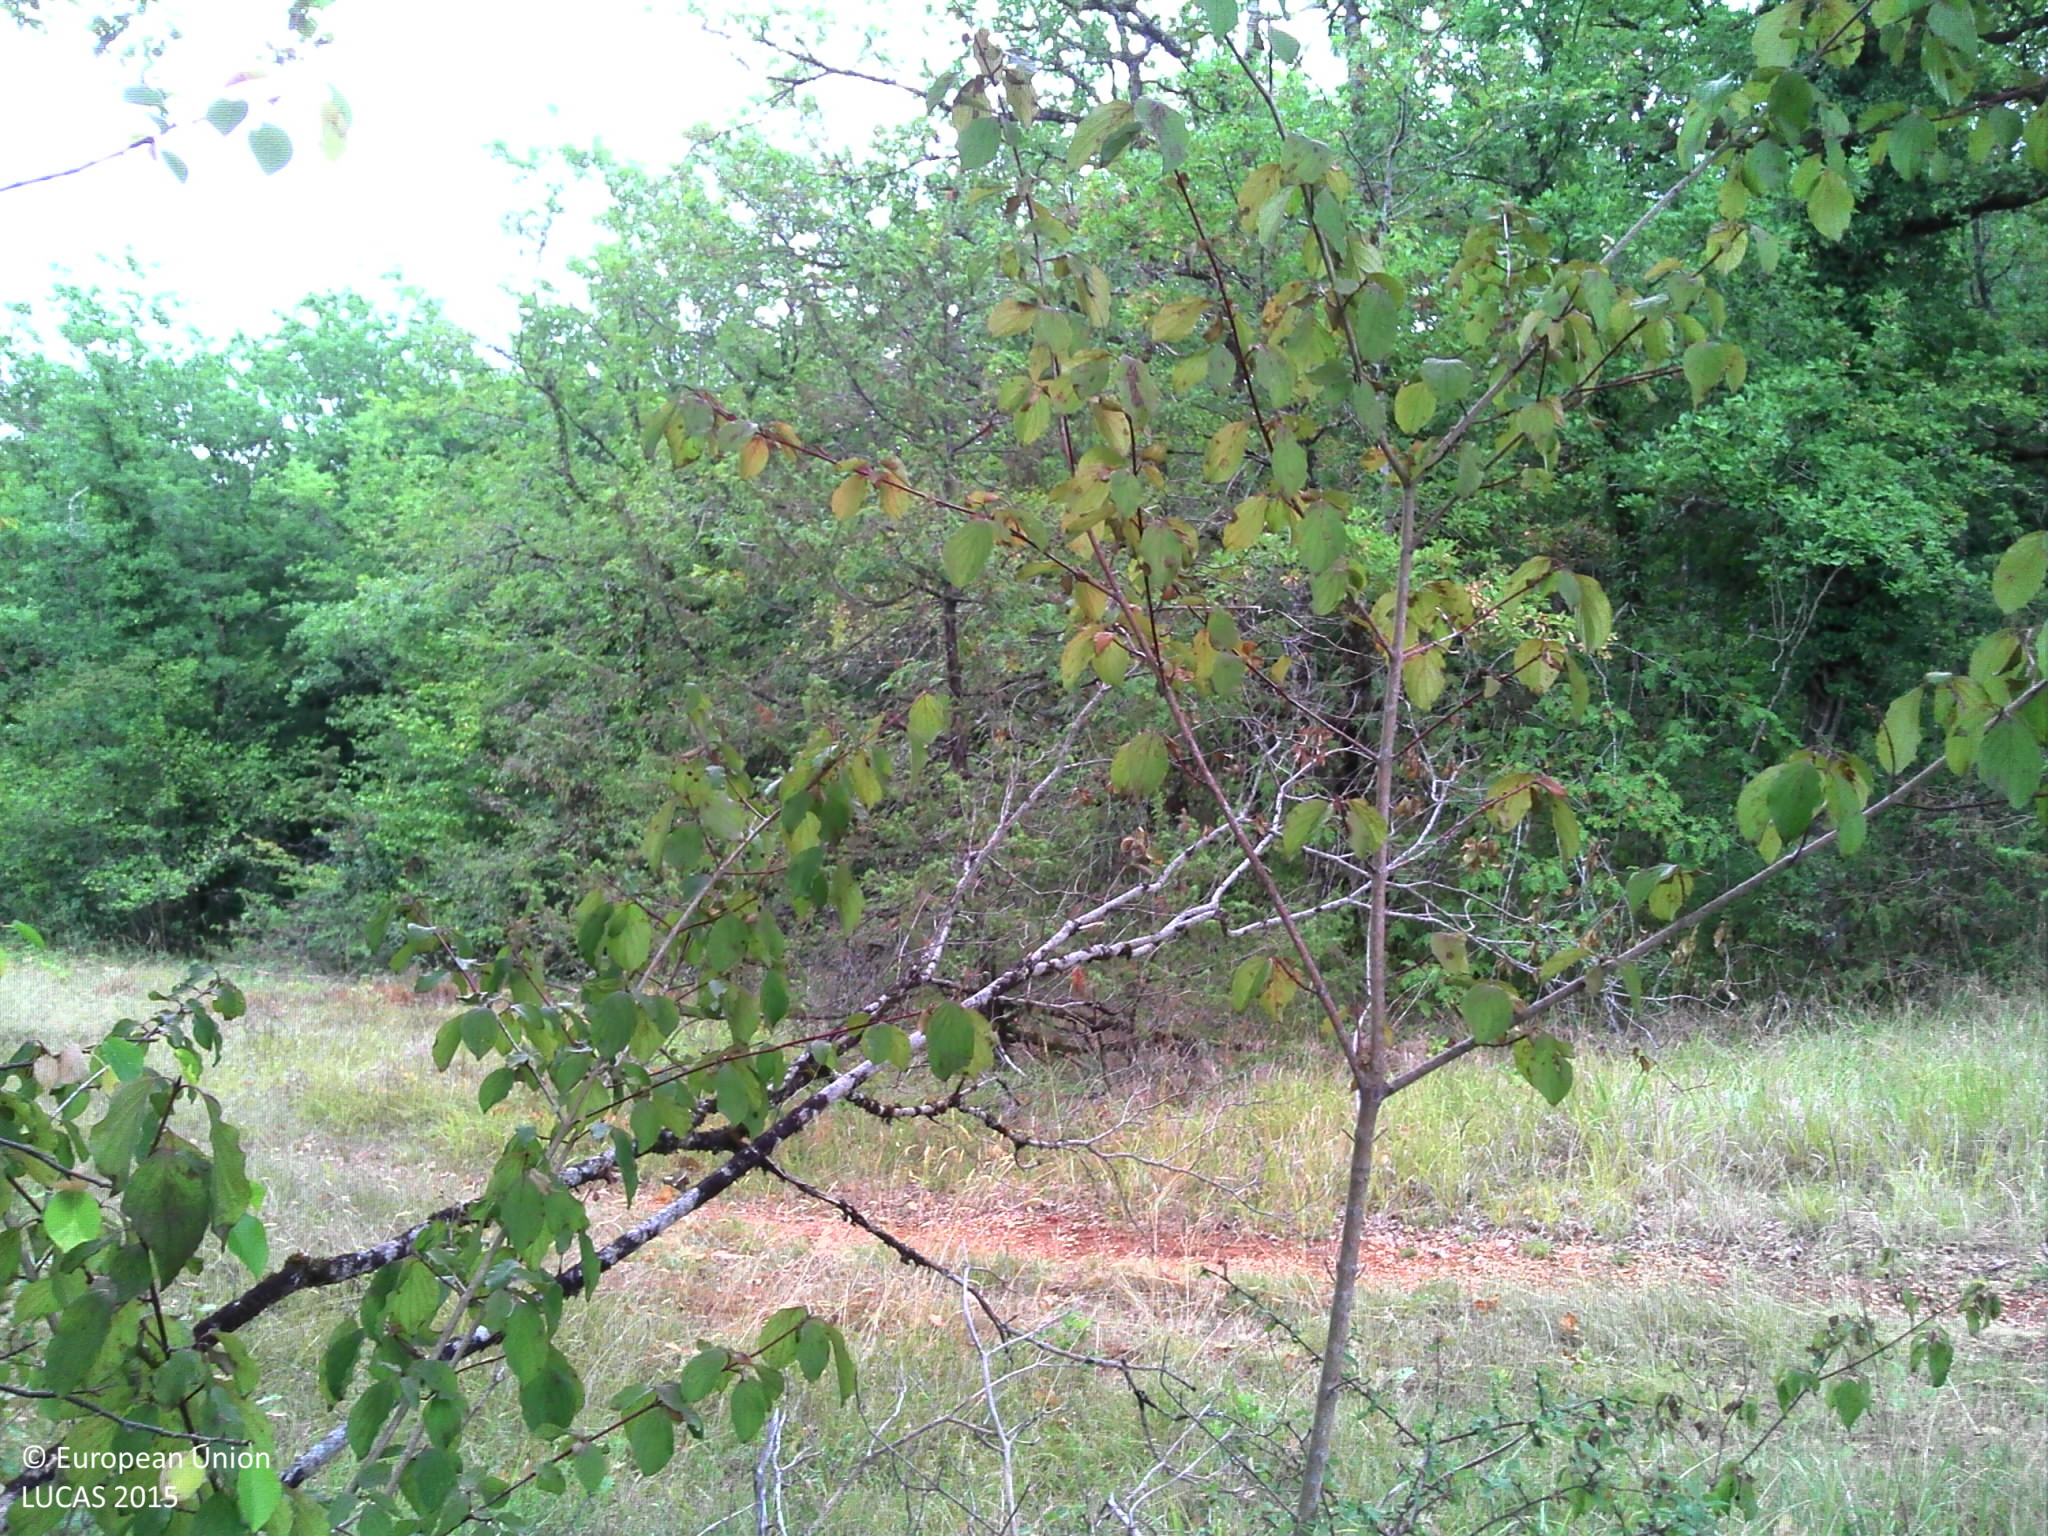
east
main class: Woodland
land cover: Broadleaved woodland
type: acidophilous oak and oak-birch forest
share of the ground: > 75 %
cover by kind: broadleaved forest trees 65 %, herbaceous plants 25 %, coniferous forest trees 5 %, shrubs 5 %
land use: Forestry
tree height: > 5 m
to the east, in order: Broadleaved woodland; Tracks; Broadleaved woodland; Tracks; Broadleaved woodland; Maize
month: July
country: FR
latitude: 45.0106
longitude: 1.4309
